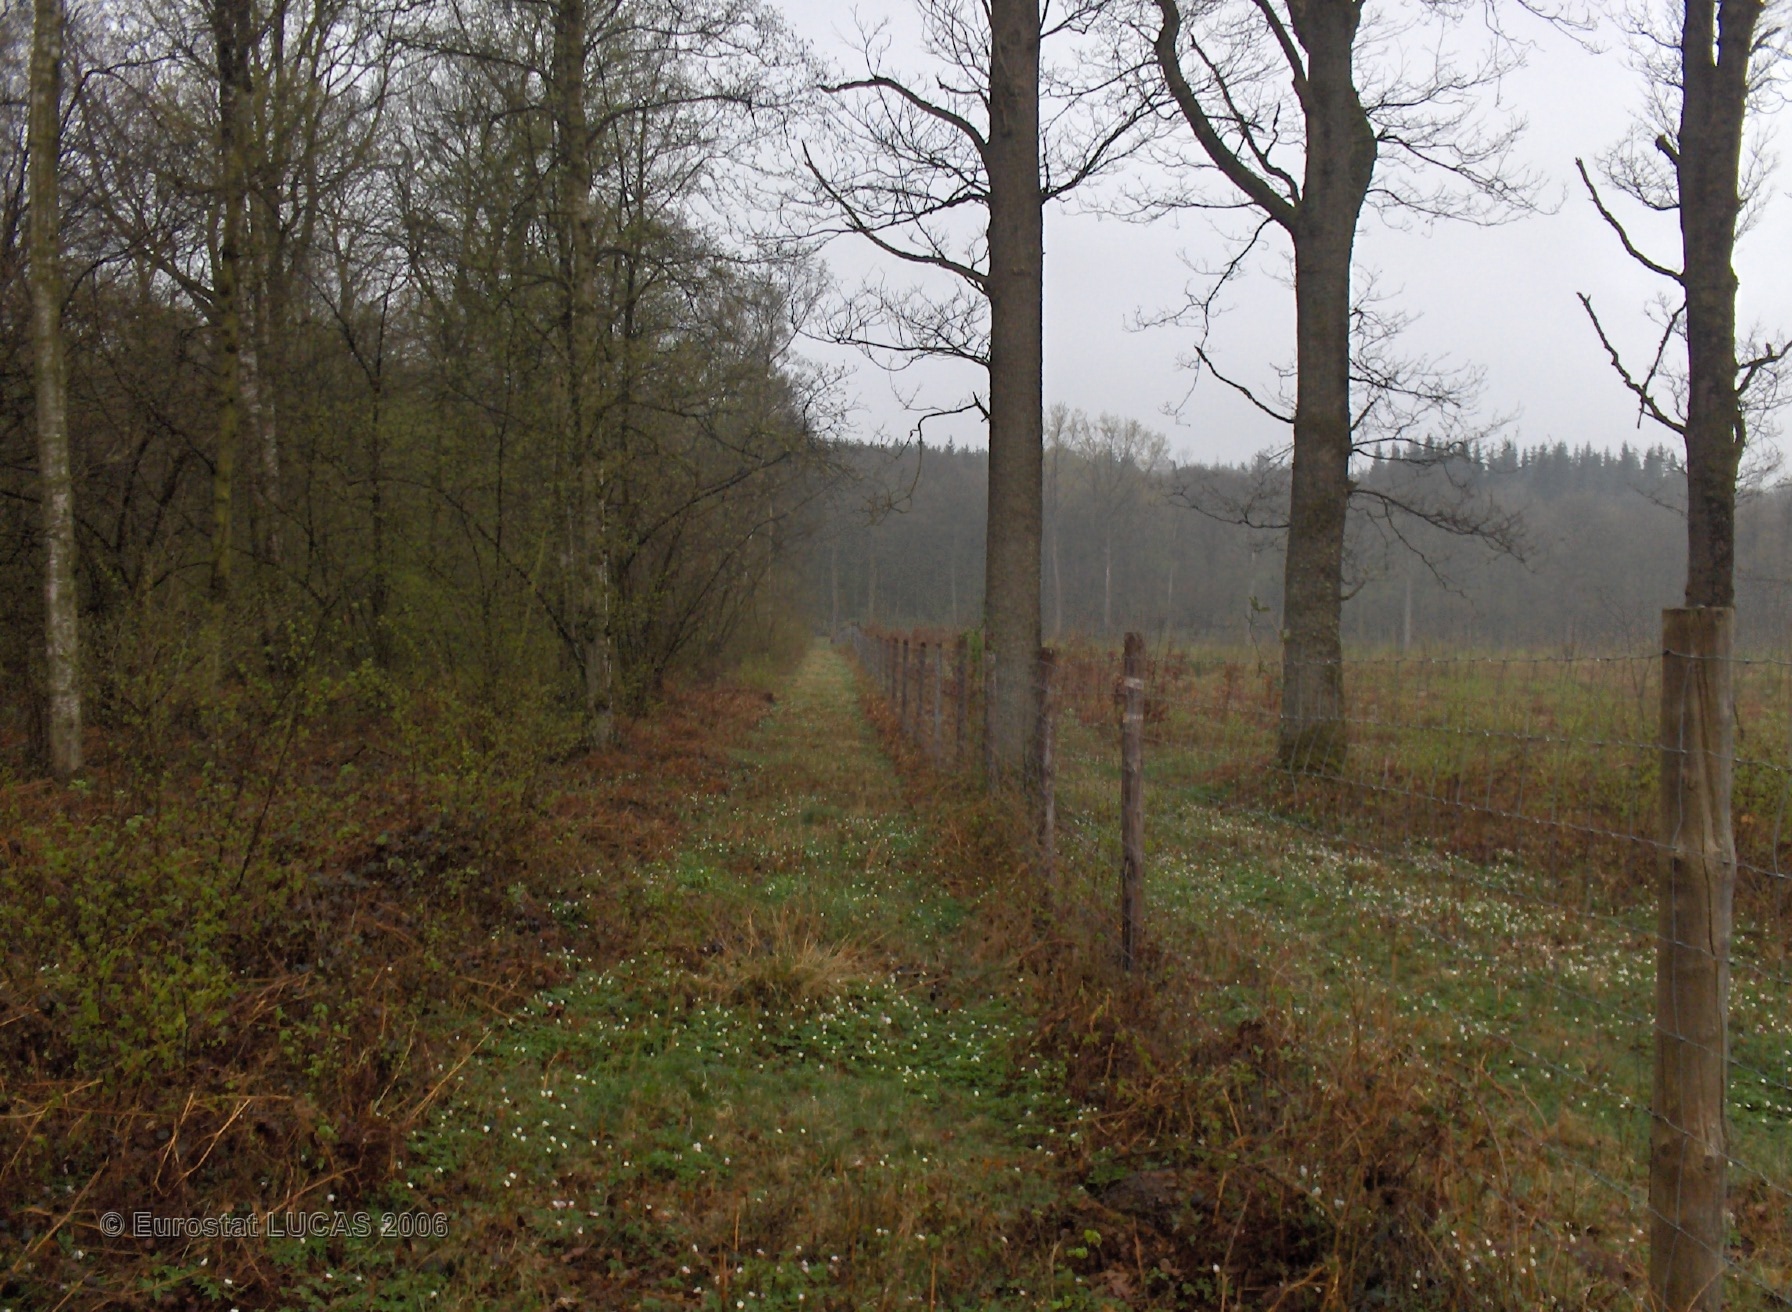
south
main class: Woodland
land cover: Mixed forest
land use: Forestry
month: April
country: BE
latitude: 50.3082
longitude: 4.5902
